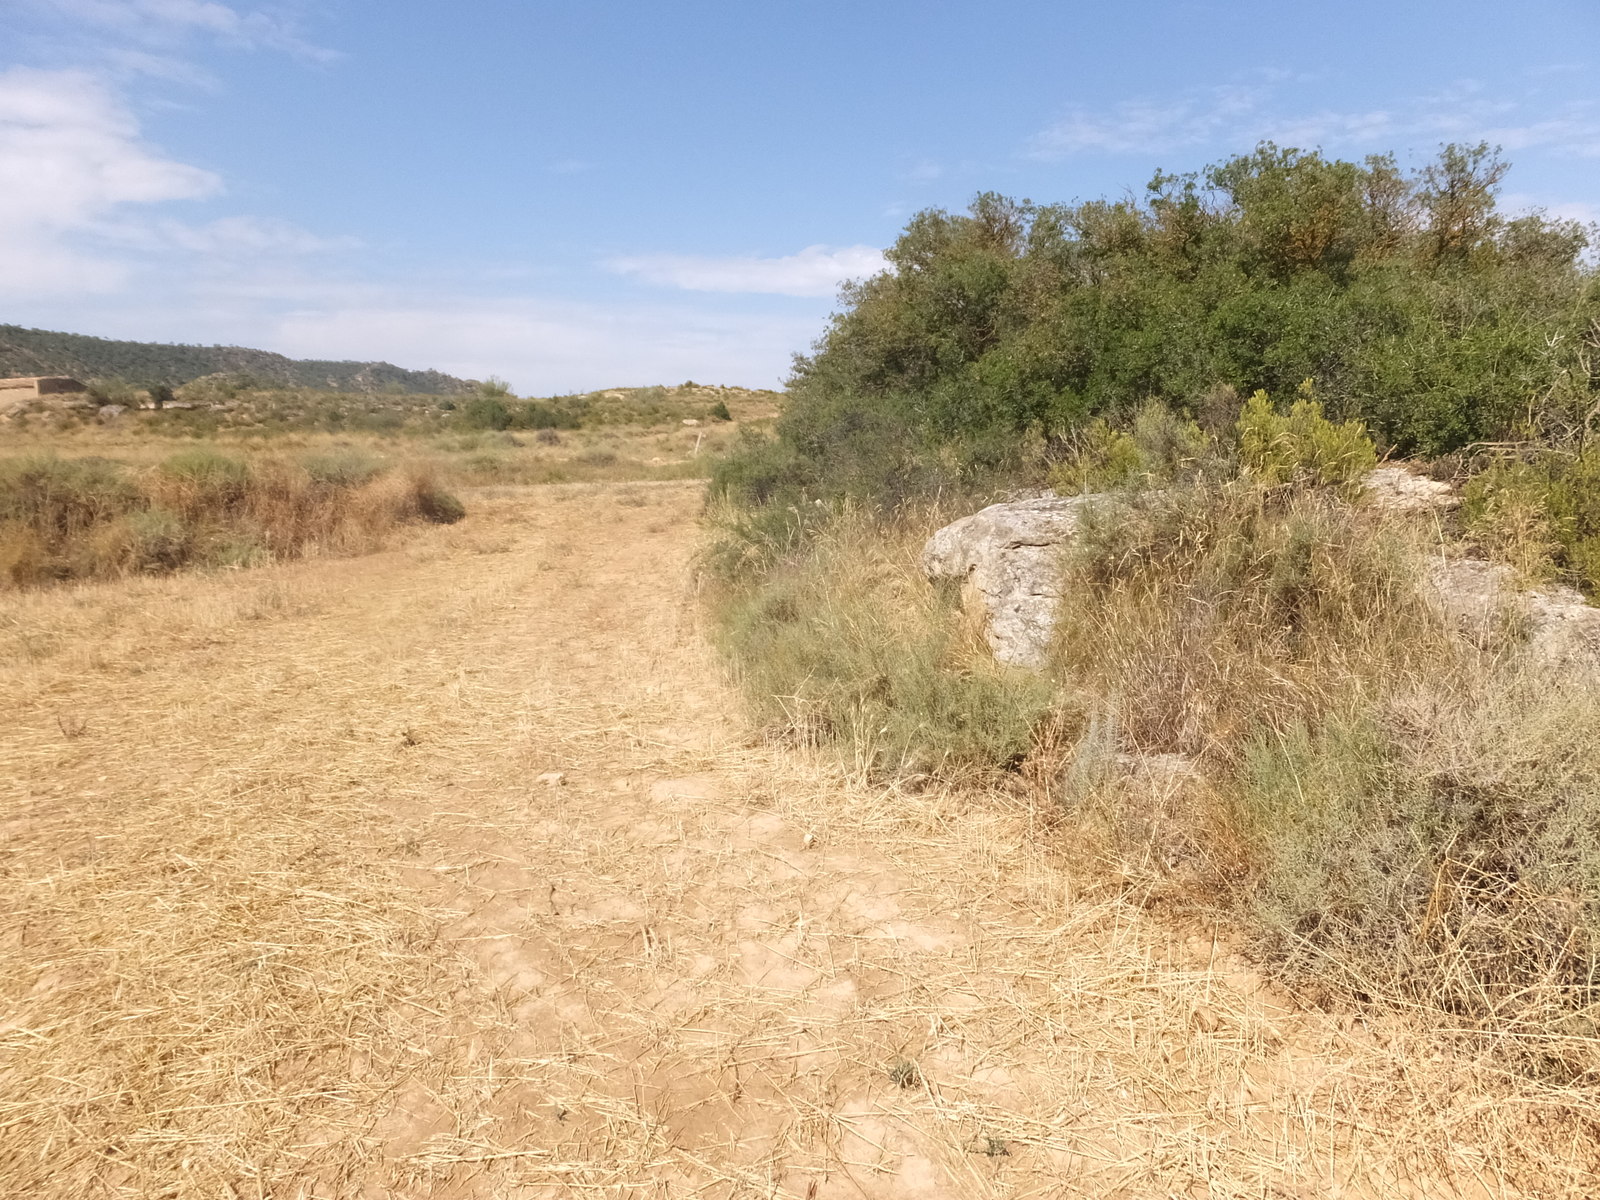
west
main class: Cropland
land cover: Barley
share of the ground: < 10 %
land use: Agriculture (excluding fallow land and kitchen gardens)
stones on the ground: < 10 %
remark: Harvested field
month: July
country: ES
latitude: 41.1695
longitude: -0.0598
